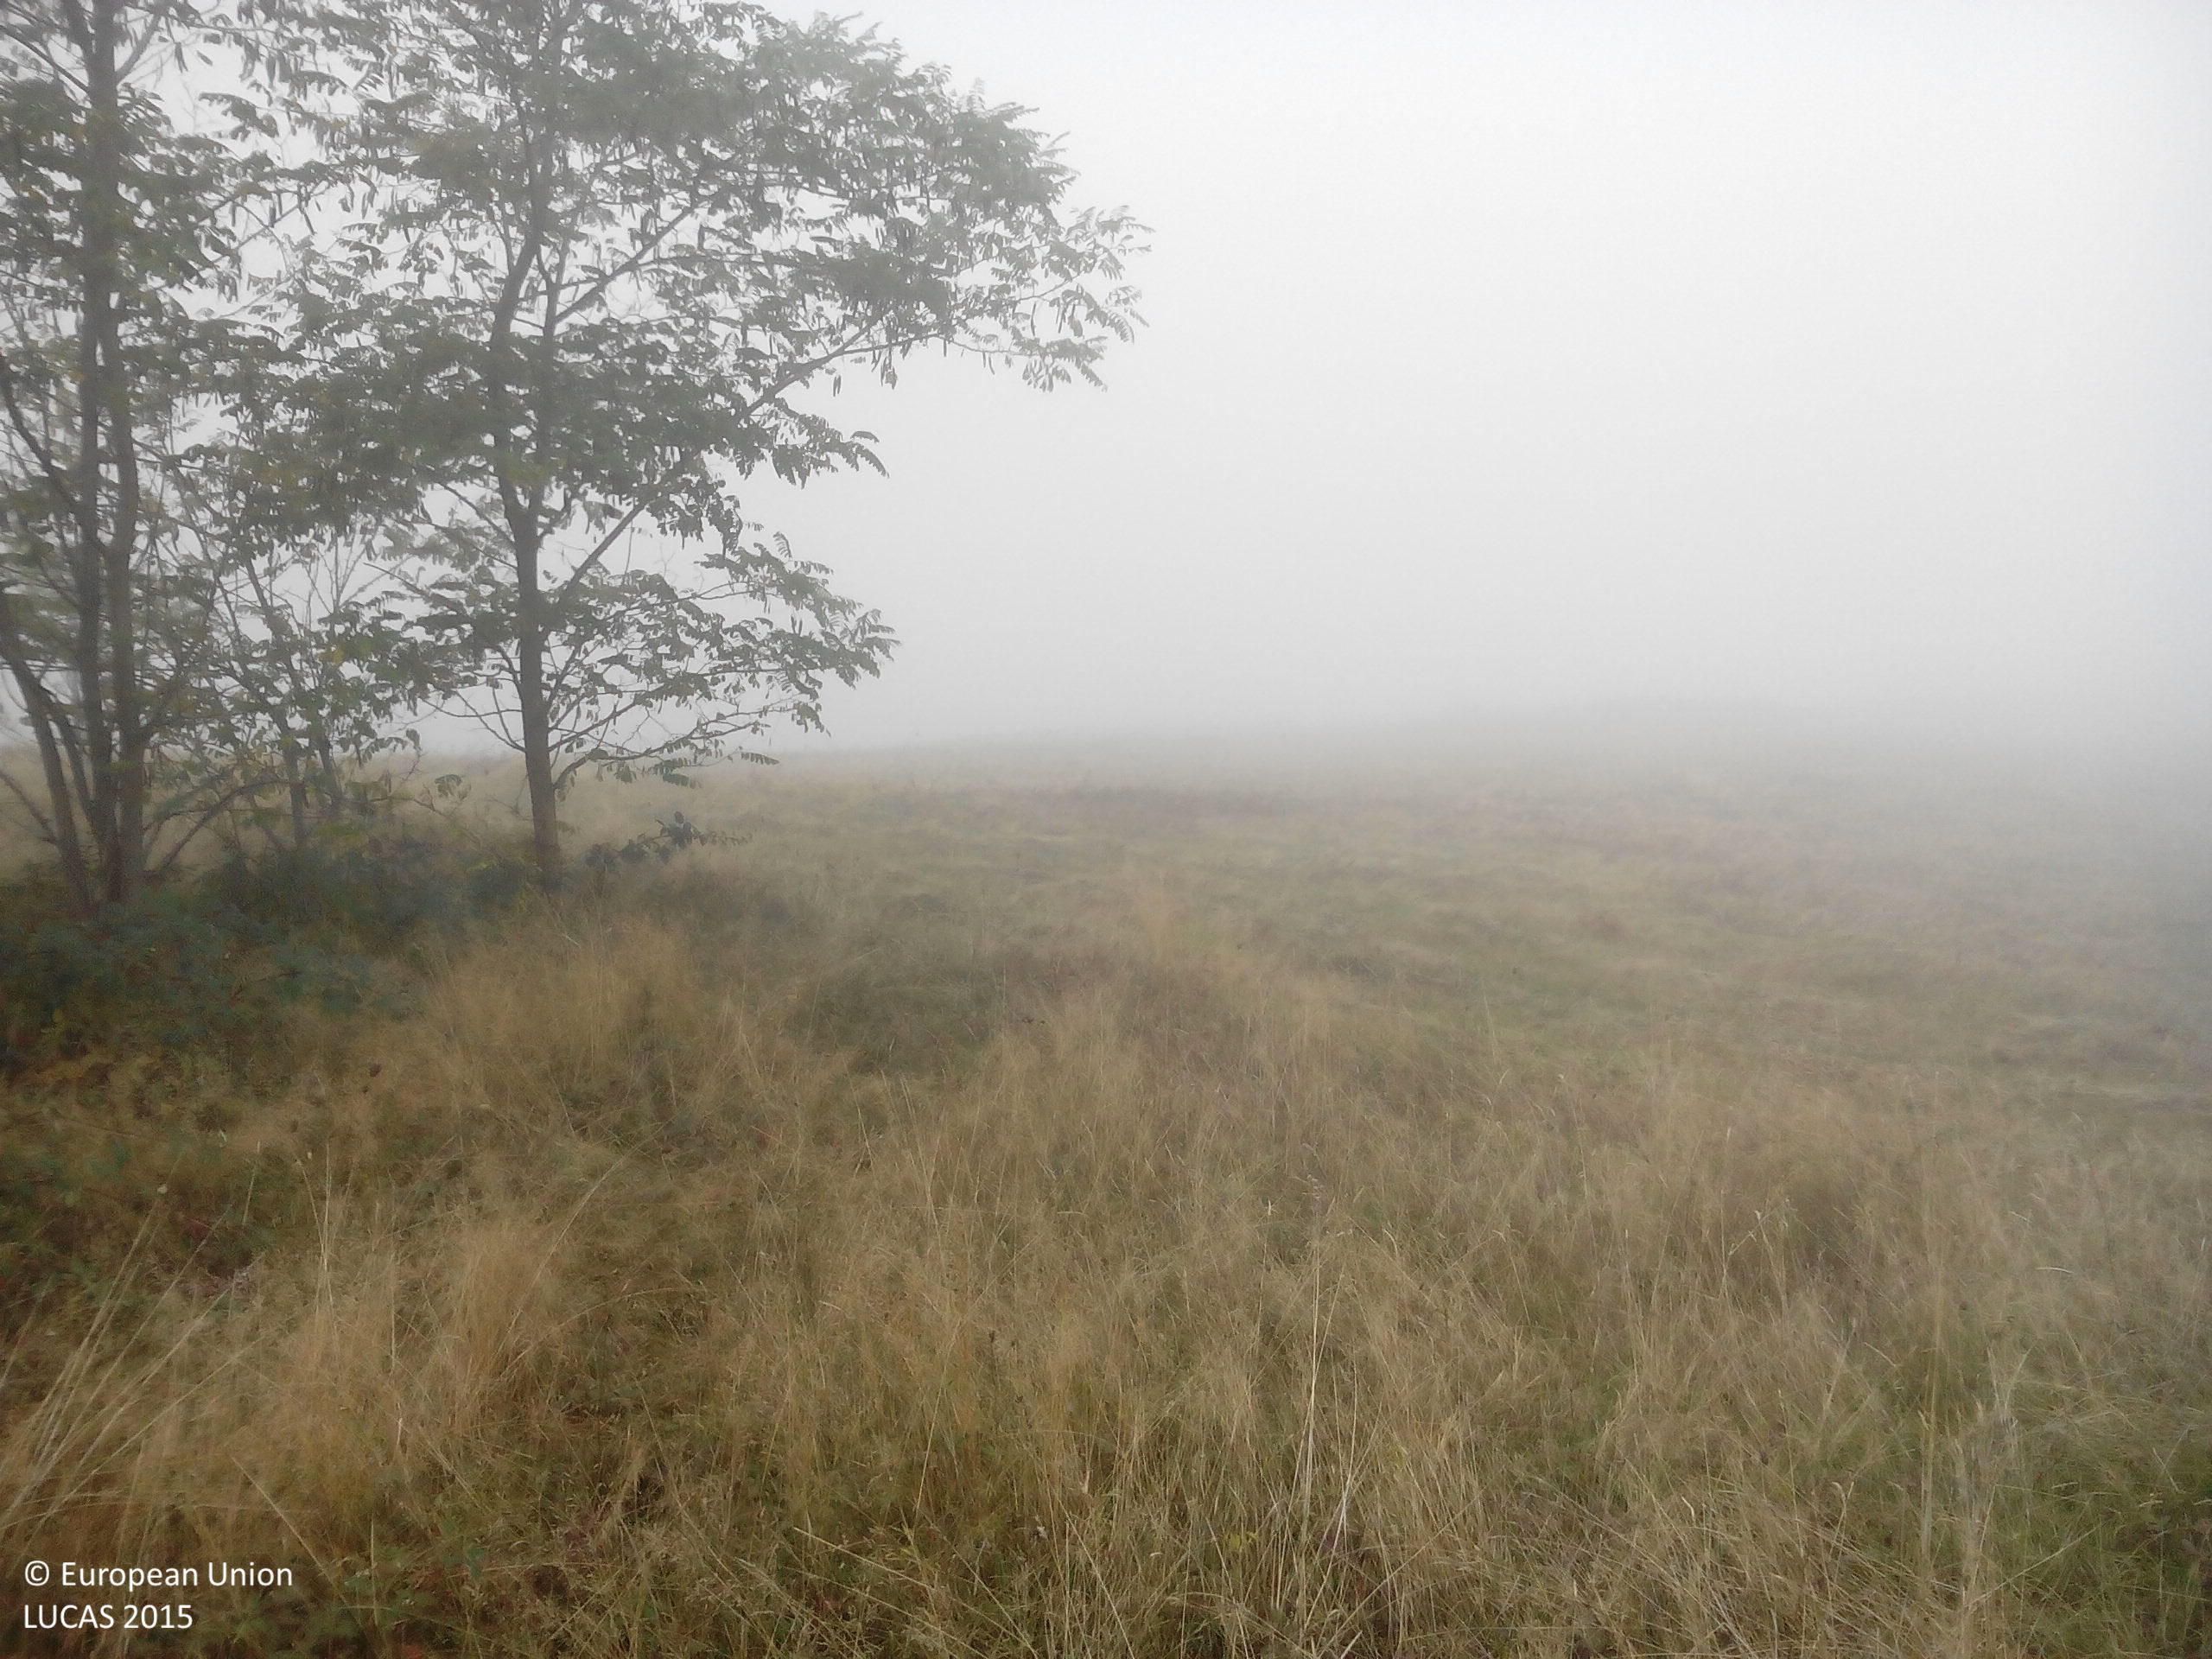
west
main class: Grassland
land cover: Grassland without tree/shrub cover
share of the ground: > 75 %
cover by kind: herbaceous plants 100 %
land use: Agriculture (excluding fallow land and kitchen gardens)
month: October
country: BG
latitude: 43.0266
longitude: 24.0264
